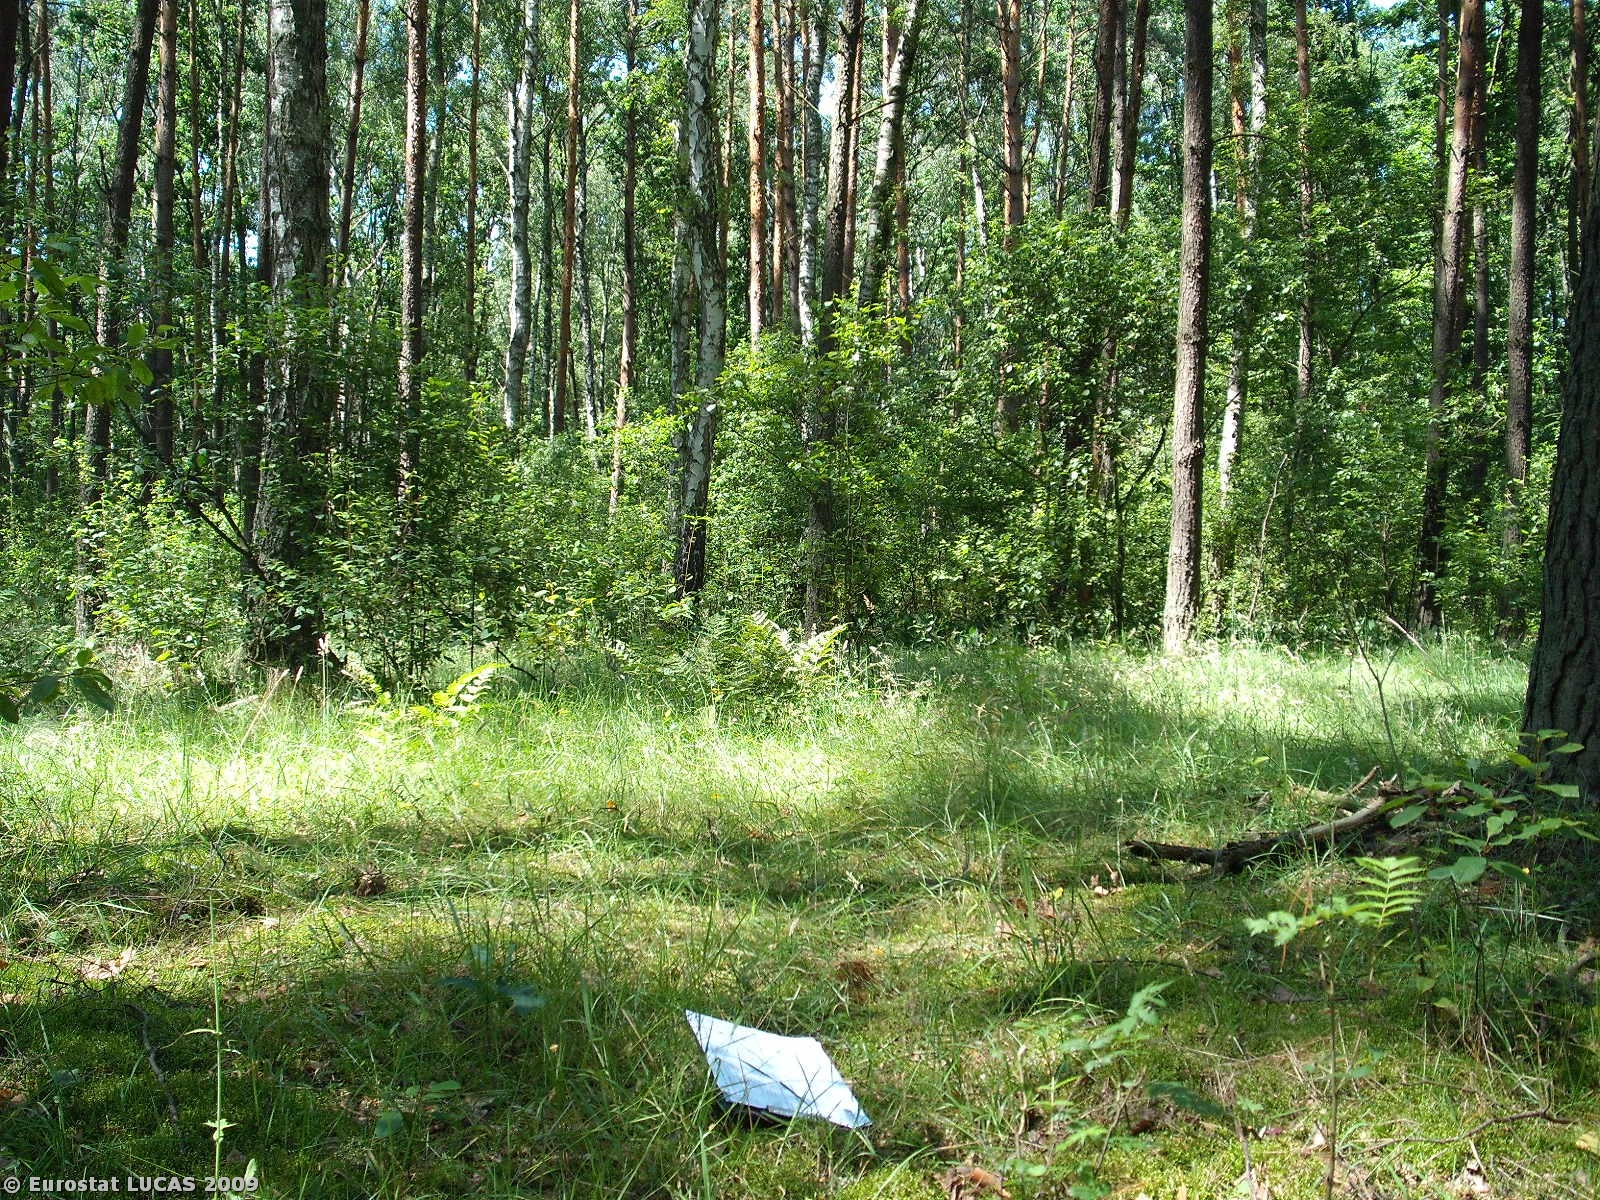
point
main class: Woodland
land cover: Coniferous woodland
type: hemiboreal forest and nemoral coniferous forest and mixed broadleaved-coniferous forest
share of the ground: > 75 %
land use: Nature reserves
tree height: > 5 m
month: July
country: PL
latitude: 52.3040
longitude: 20.7618
